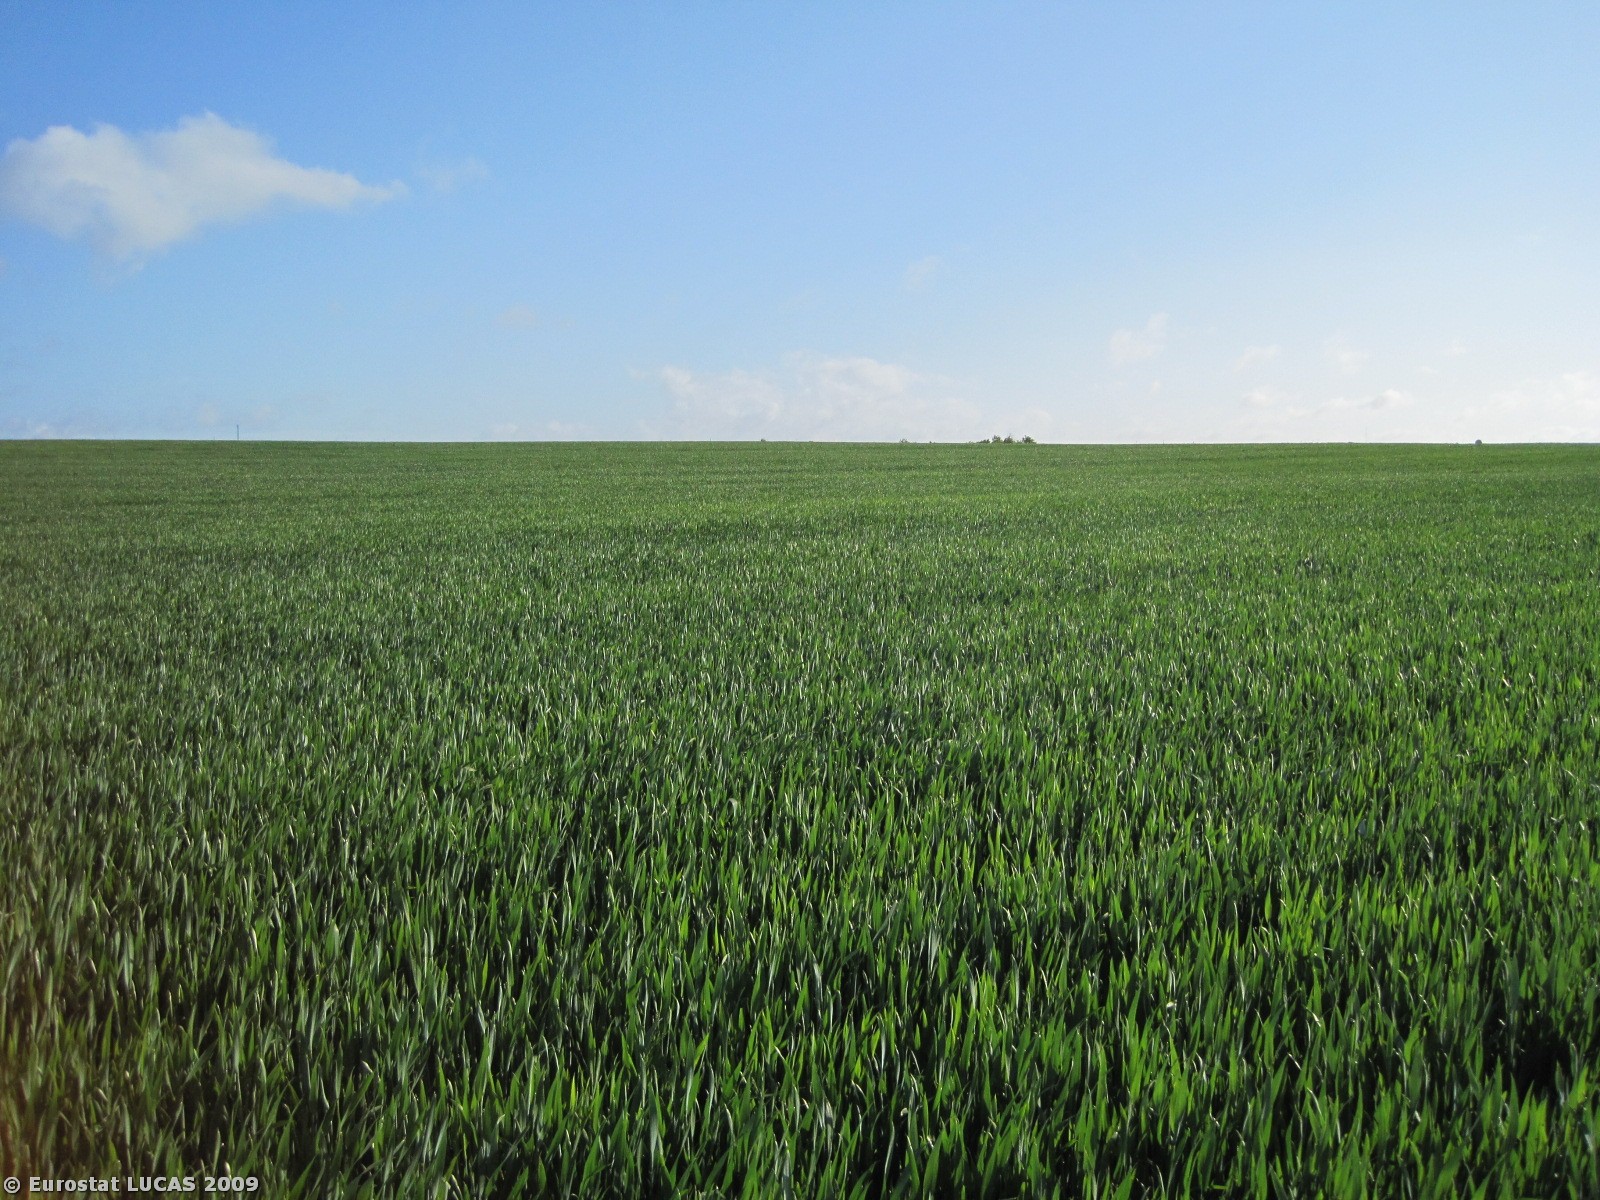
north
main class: Cropland
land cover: Common wheat
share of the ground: > 75 %
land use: Agriculture (excluding fallow land and kitchen gardens)
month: May
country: DK
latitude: 56.5472
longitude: 10.0812
